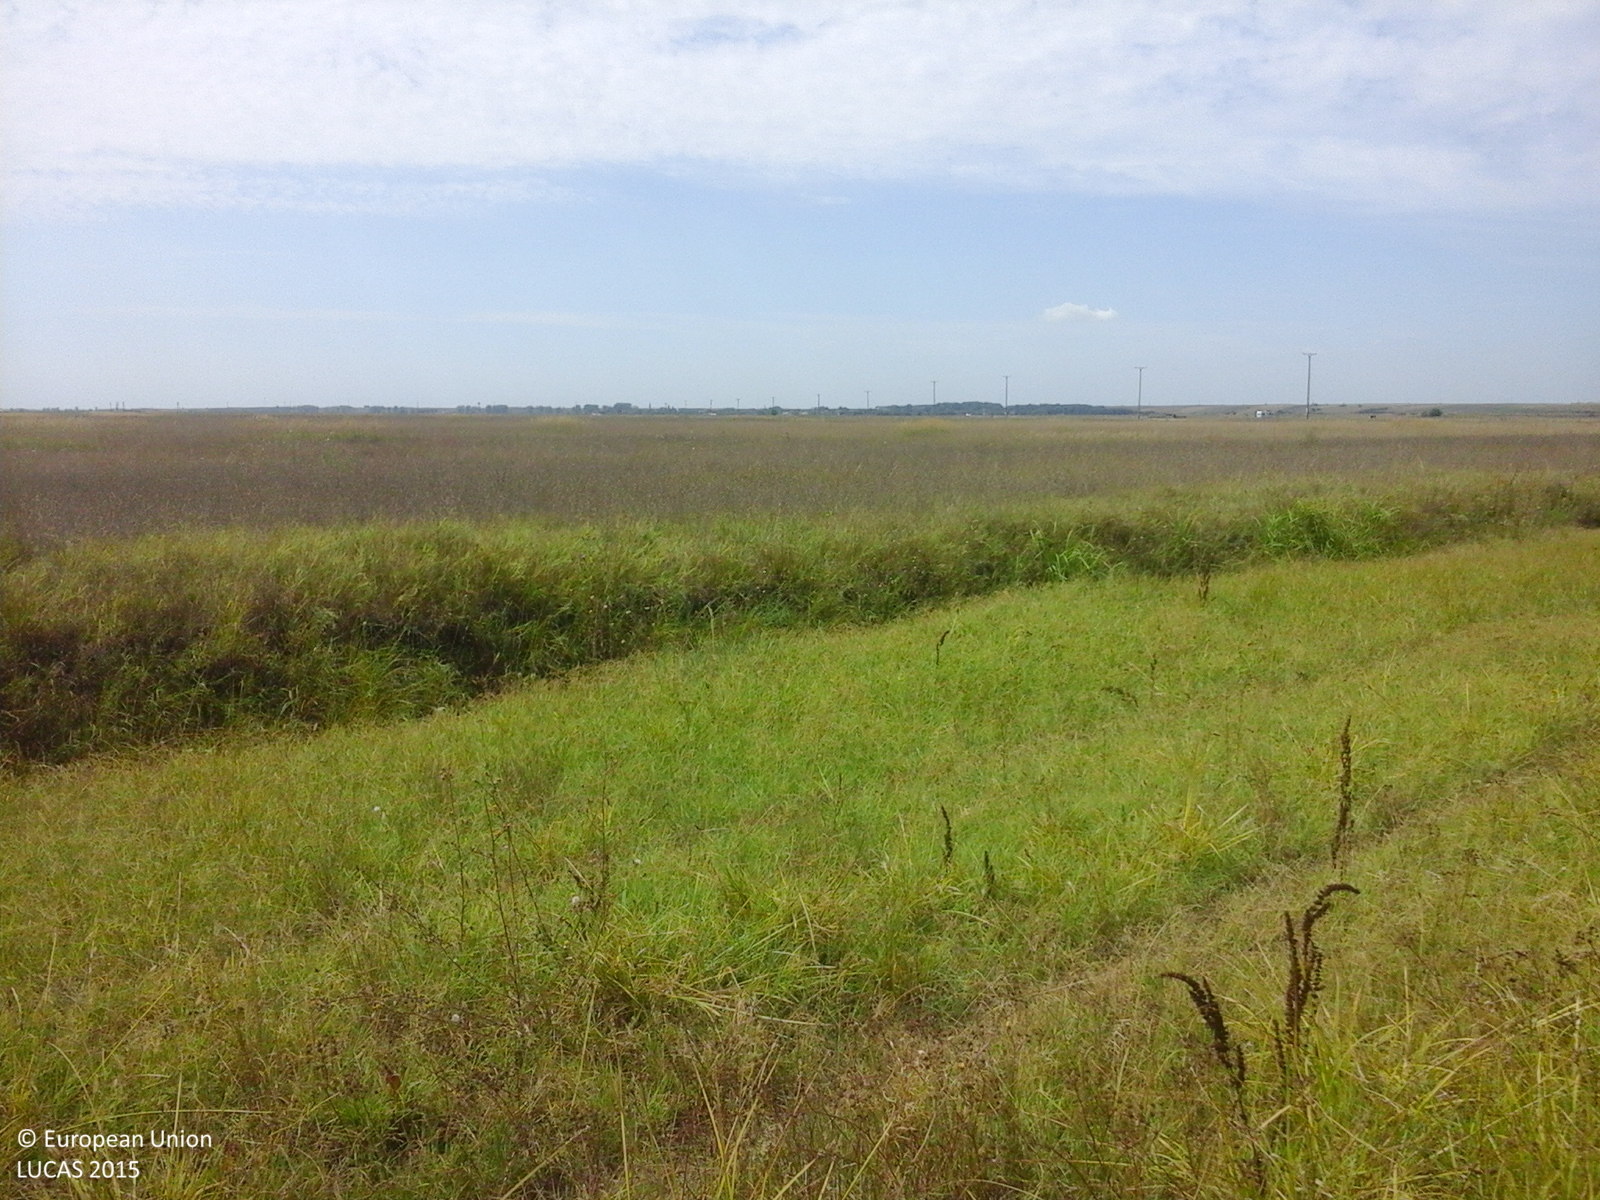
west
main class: Cropland
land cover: Soya
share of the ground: > 75 %
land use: Agriculture (excluding fallow land and kitchen gardens)
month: August
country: RO
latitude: 45.2916
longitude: 21.3390
